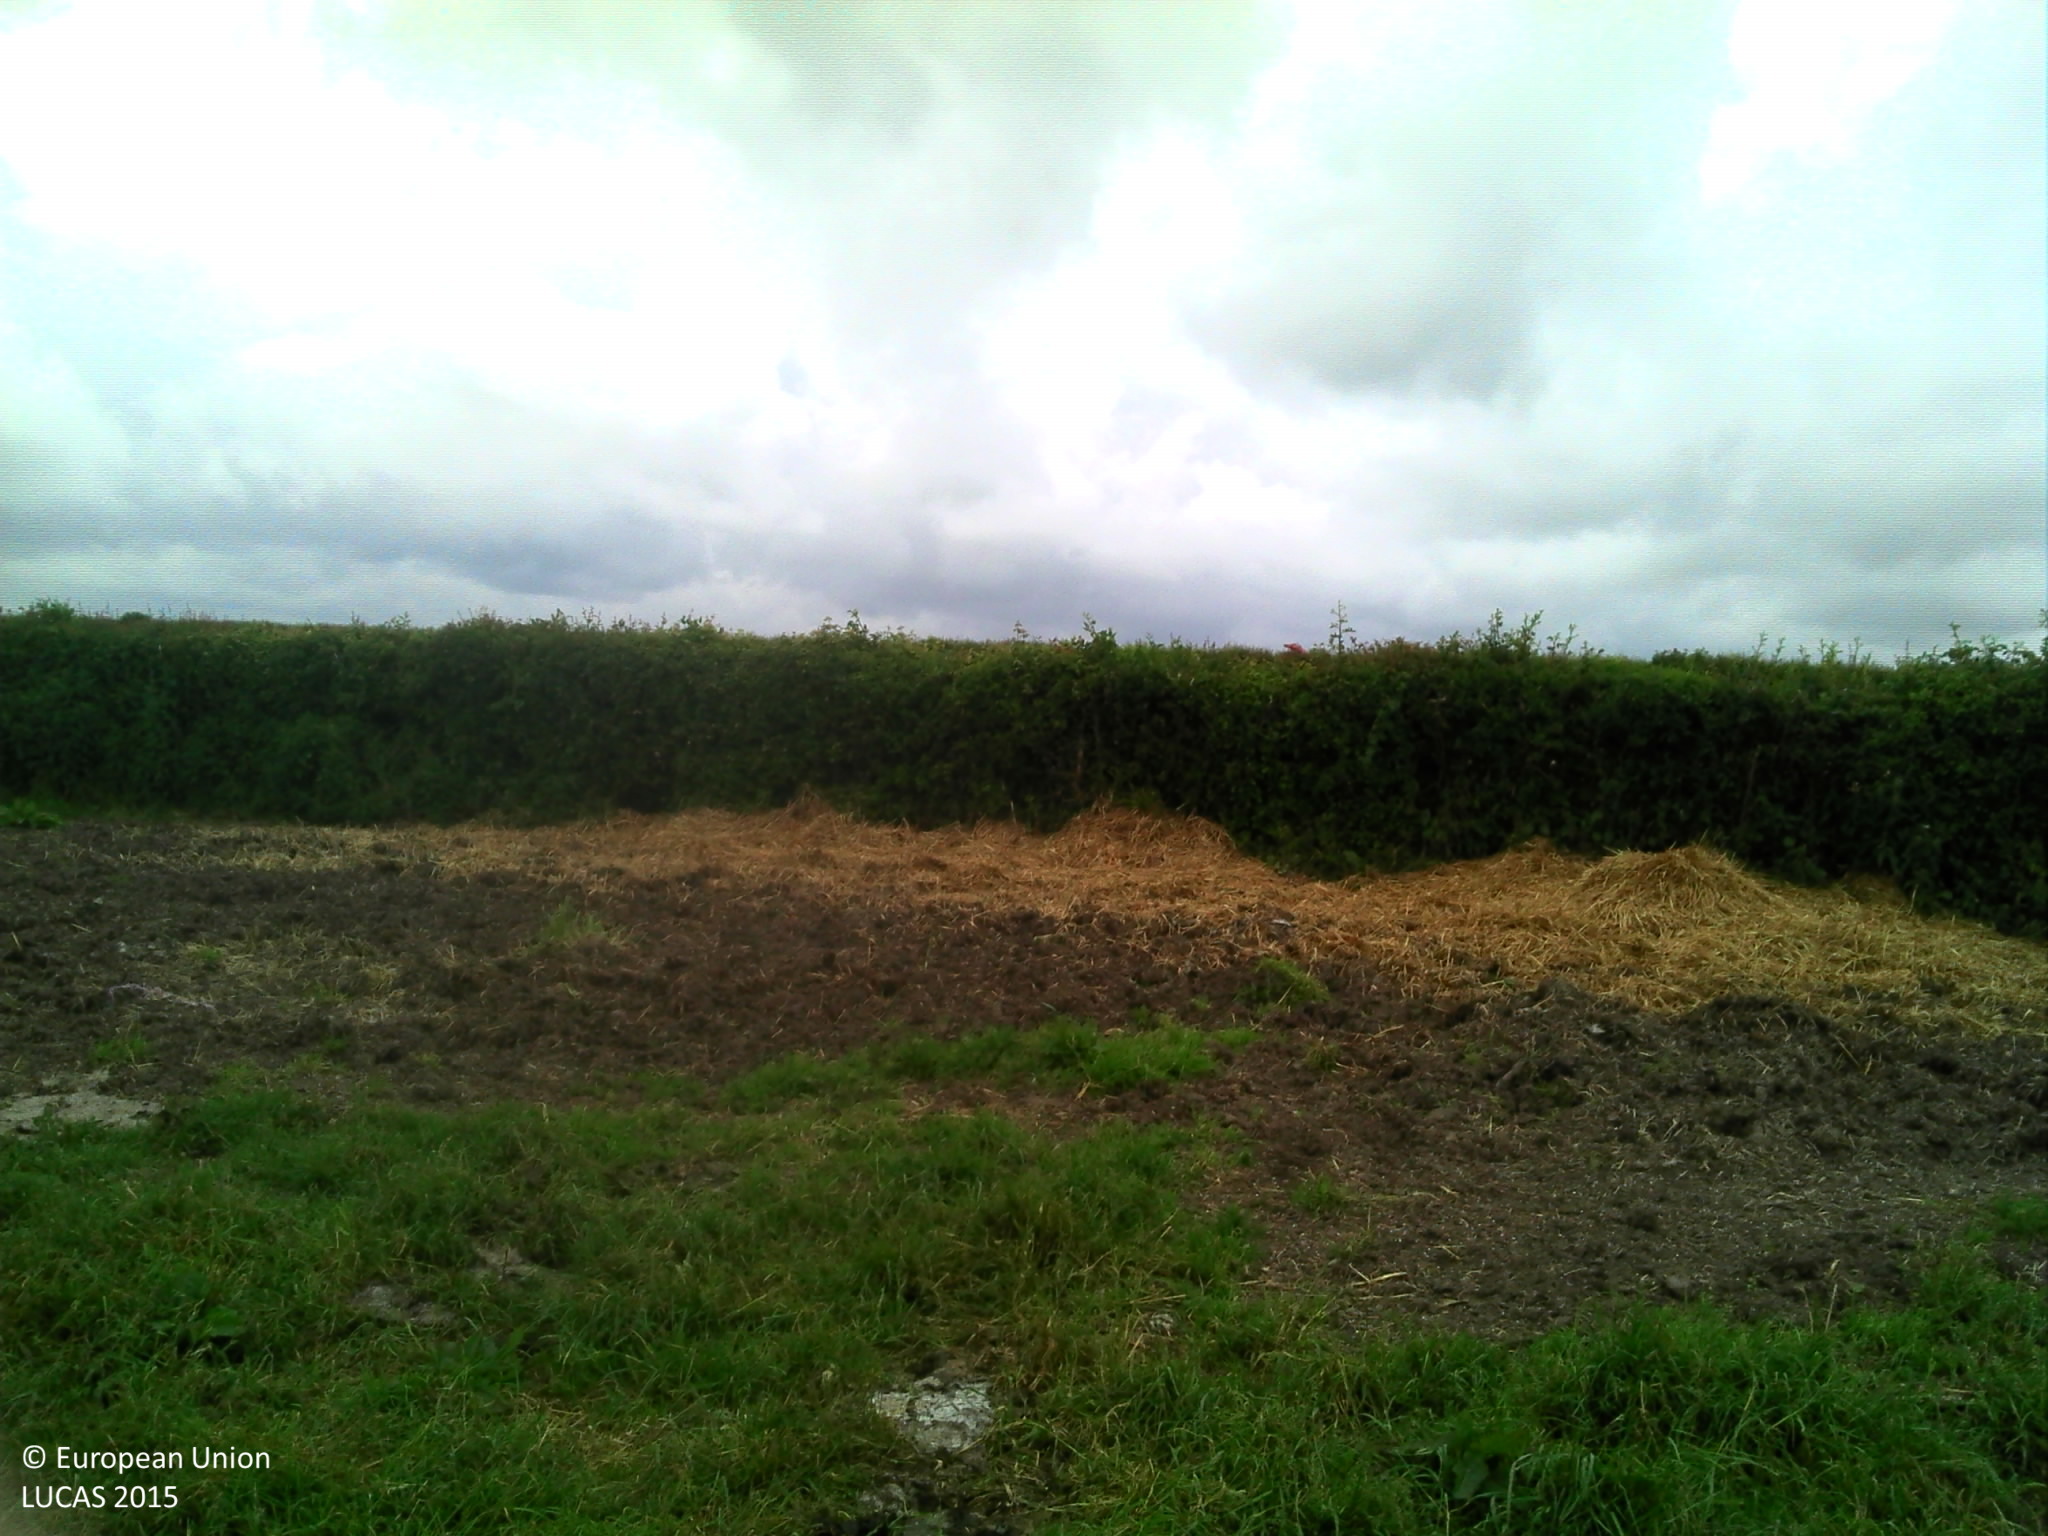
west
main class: Grassland
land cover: Grassland without tree/shrub cover
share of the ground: > 75 %
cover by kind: herbaceous plants 100 %
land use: Agriculture (excluding fallow land and kitchen gardens)
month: May
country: FR
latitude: 50.0599
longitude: 1.6710
